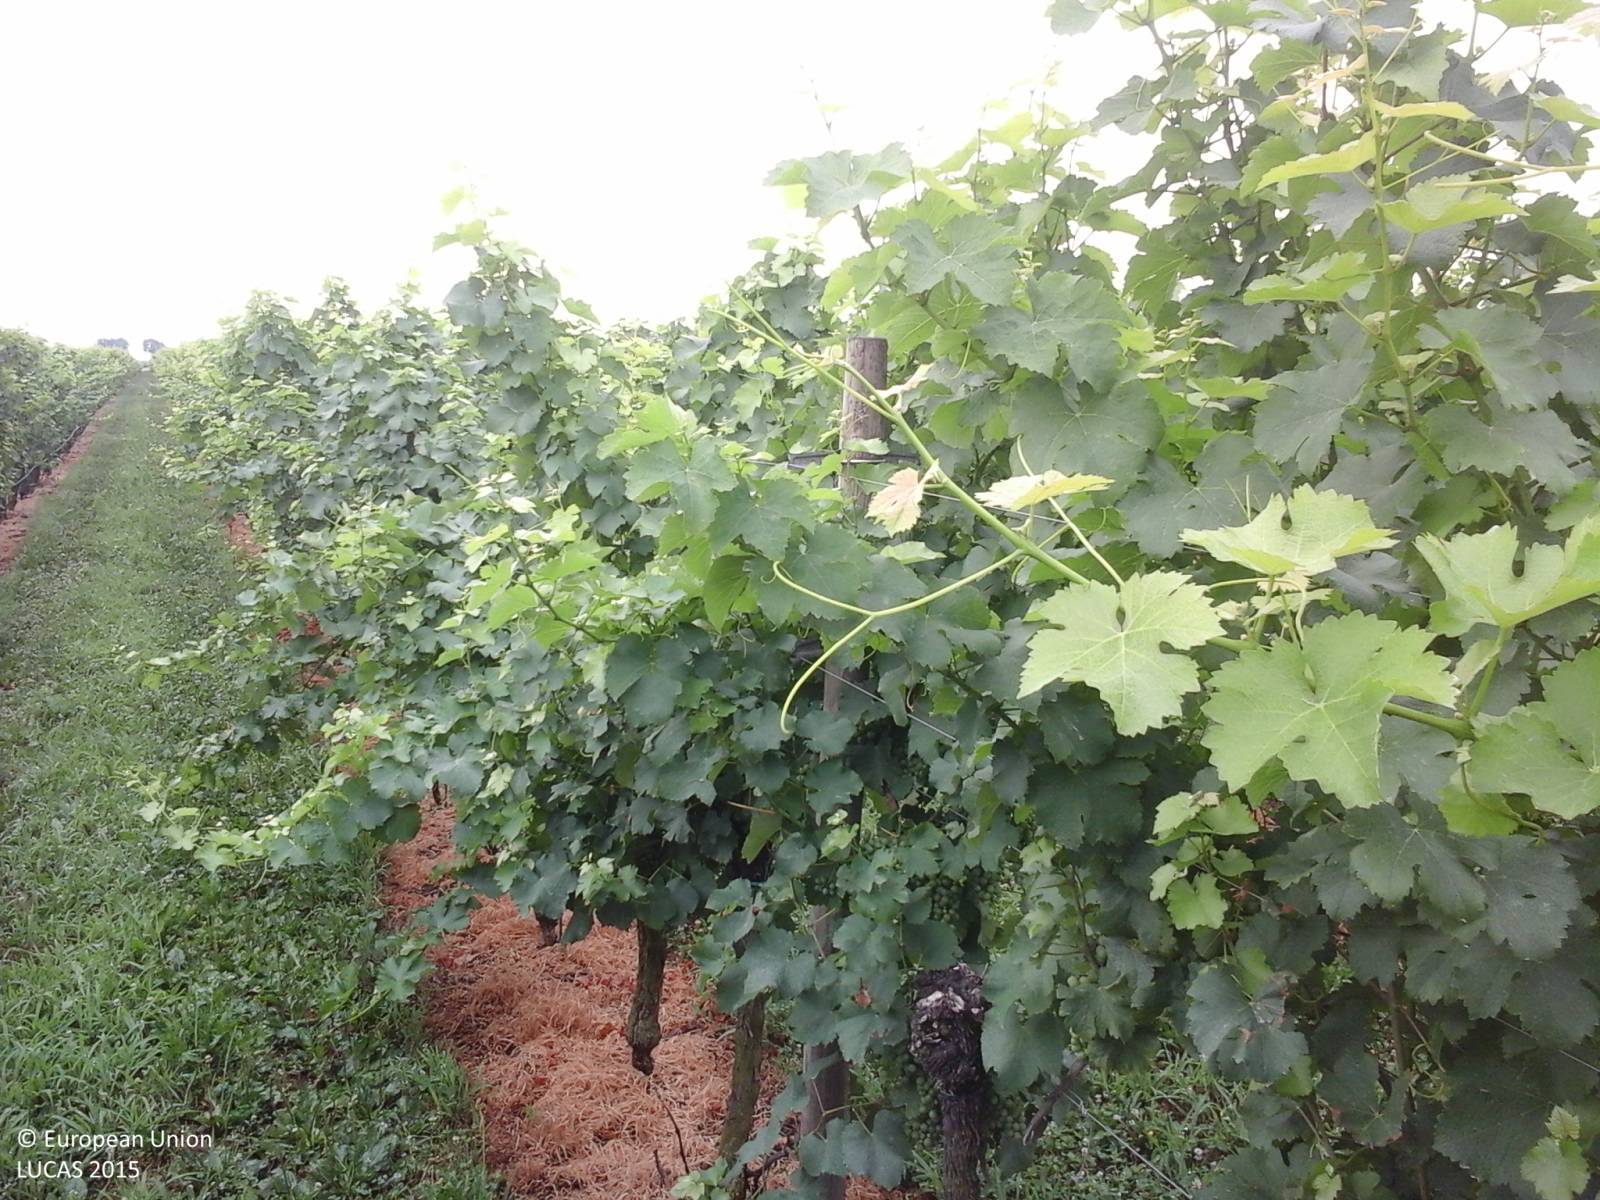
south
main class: Cropland
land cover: Vineyards
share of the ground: 50 - 75 %
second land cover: Grassland without tree/shrub cover
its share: > 75 %
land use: Agriculture (excluding fallow land and kitchen gardens)
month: July
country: IT
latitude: 45.9838
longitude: 13.0299
